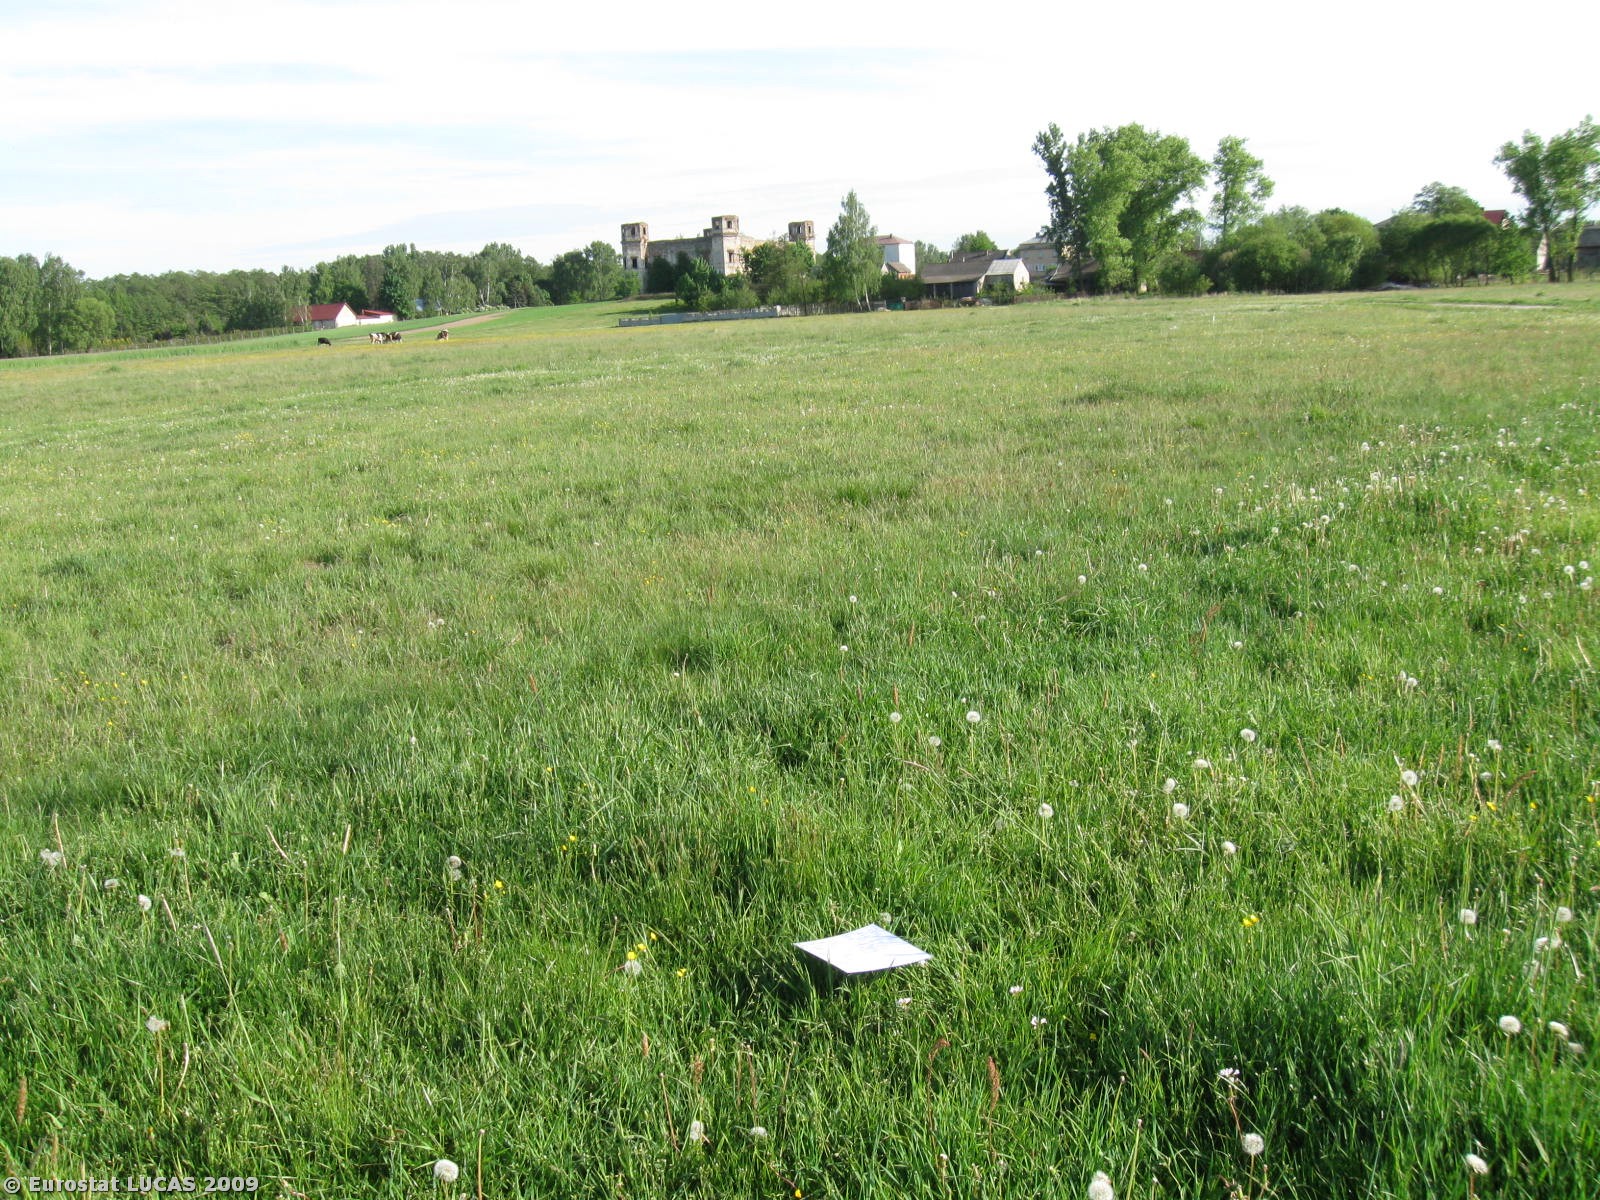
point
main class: Grassland
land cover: Grassland without tree/shrub cover
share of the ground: > 75 %
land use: Agriculture (excluding fallow land and kitchen gardens)
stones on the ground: < 10 %
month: May
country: PL
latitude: 50.8960
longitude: 20.4883
